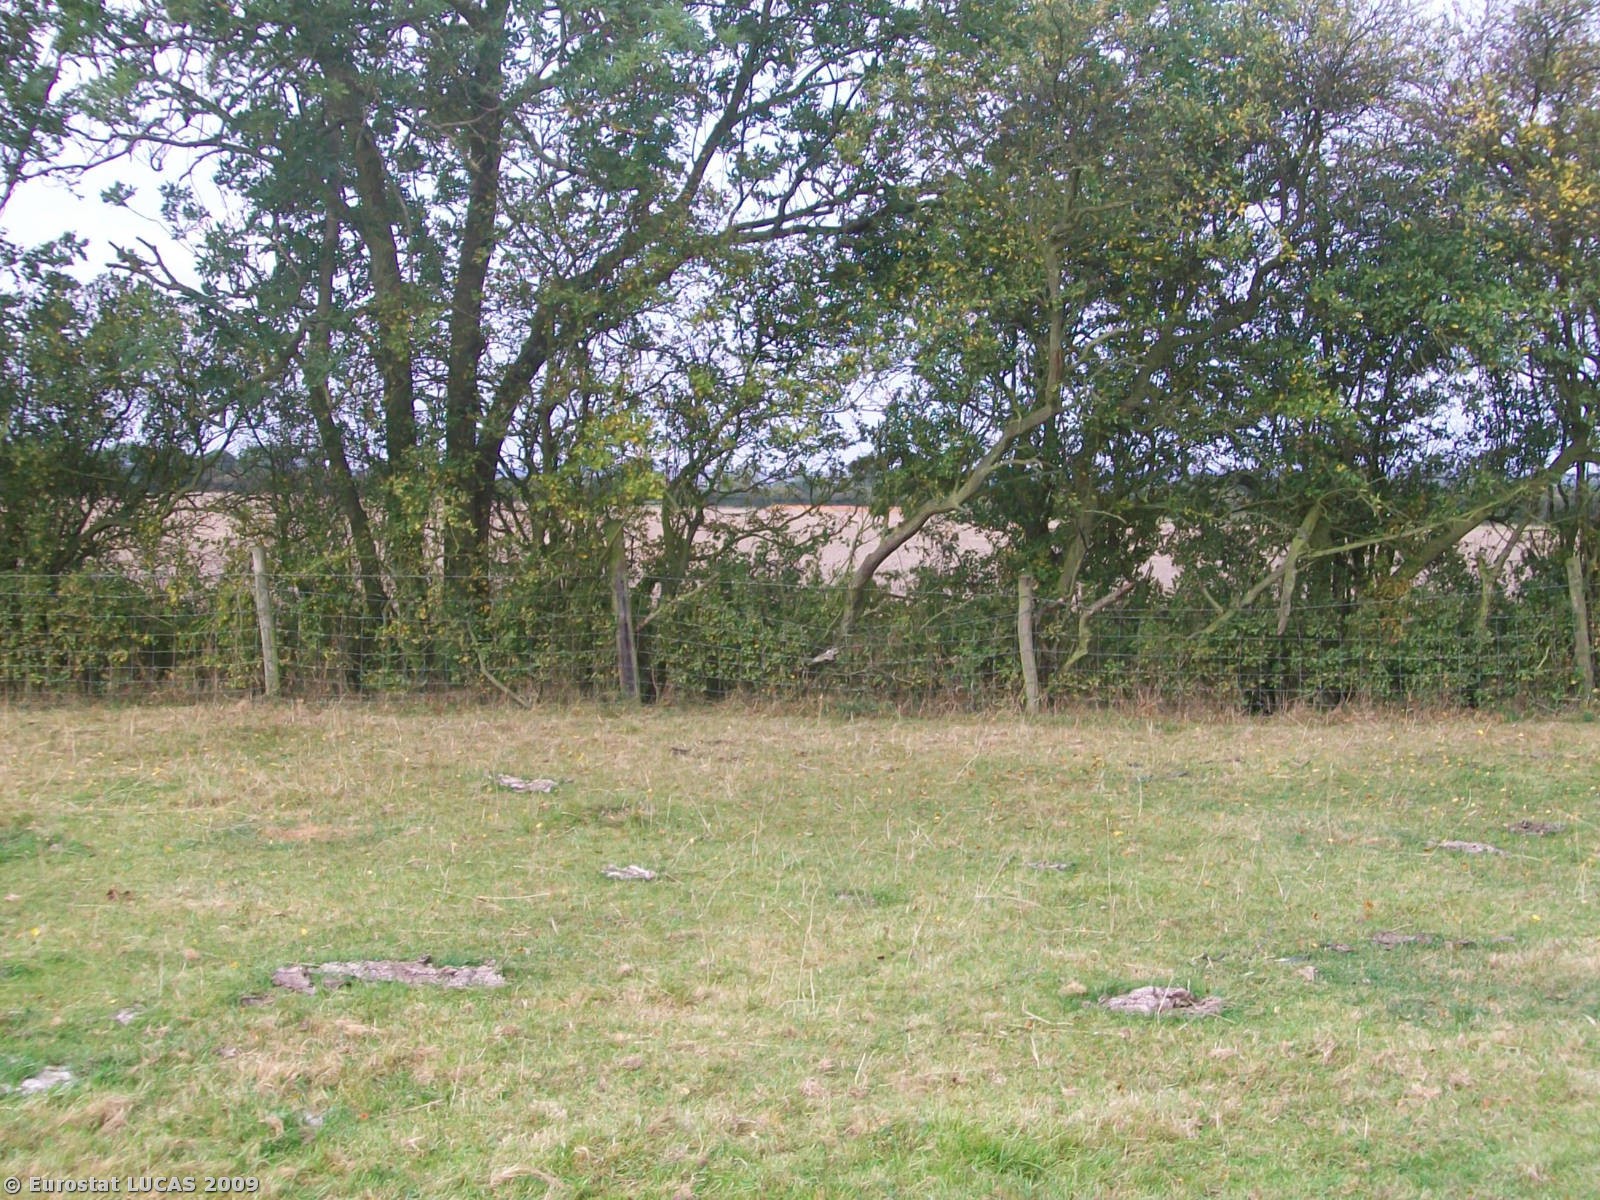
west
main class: Grassland
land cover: Grassland without tree/shrub cover
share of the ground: > 75 %
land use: Agriculture (excluding fallow land and kitchen gardens)
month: September
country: GB
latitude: 52.5182
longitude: -1.3819
